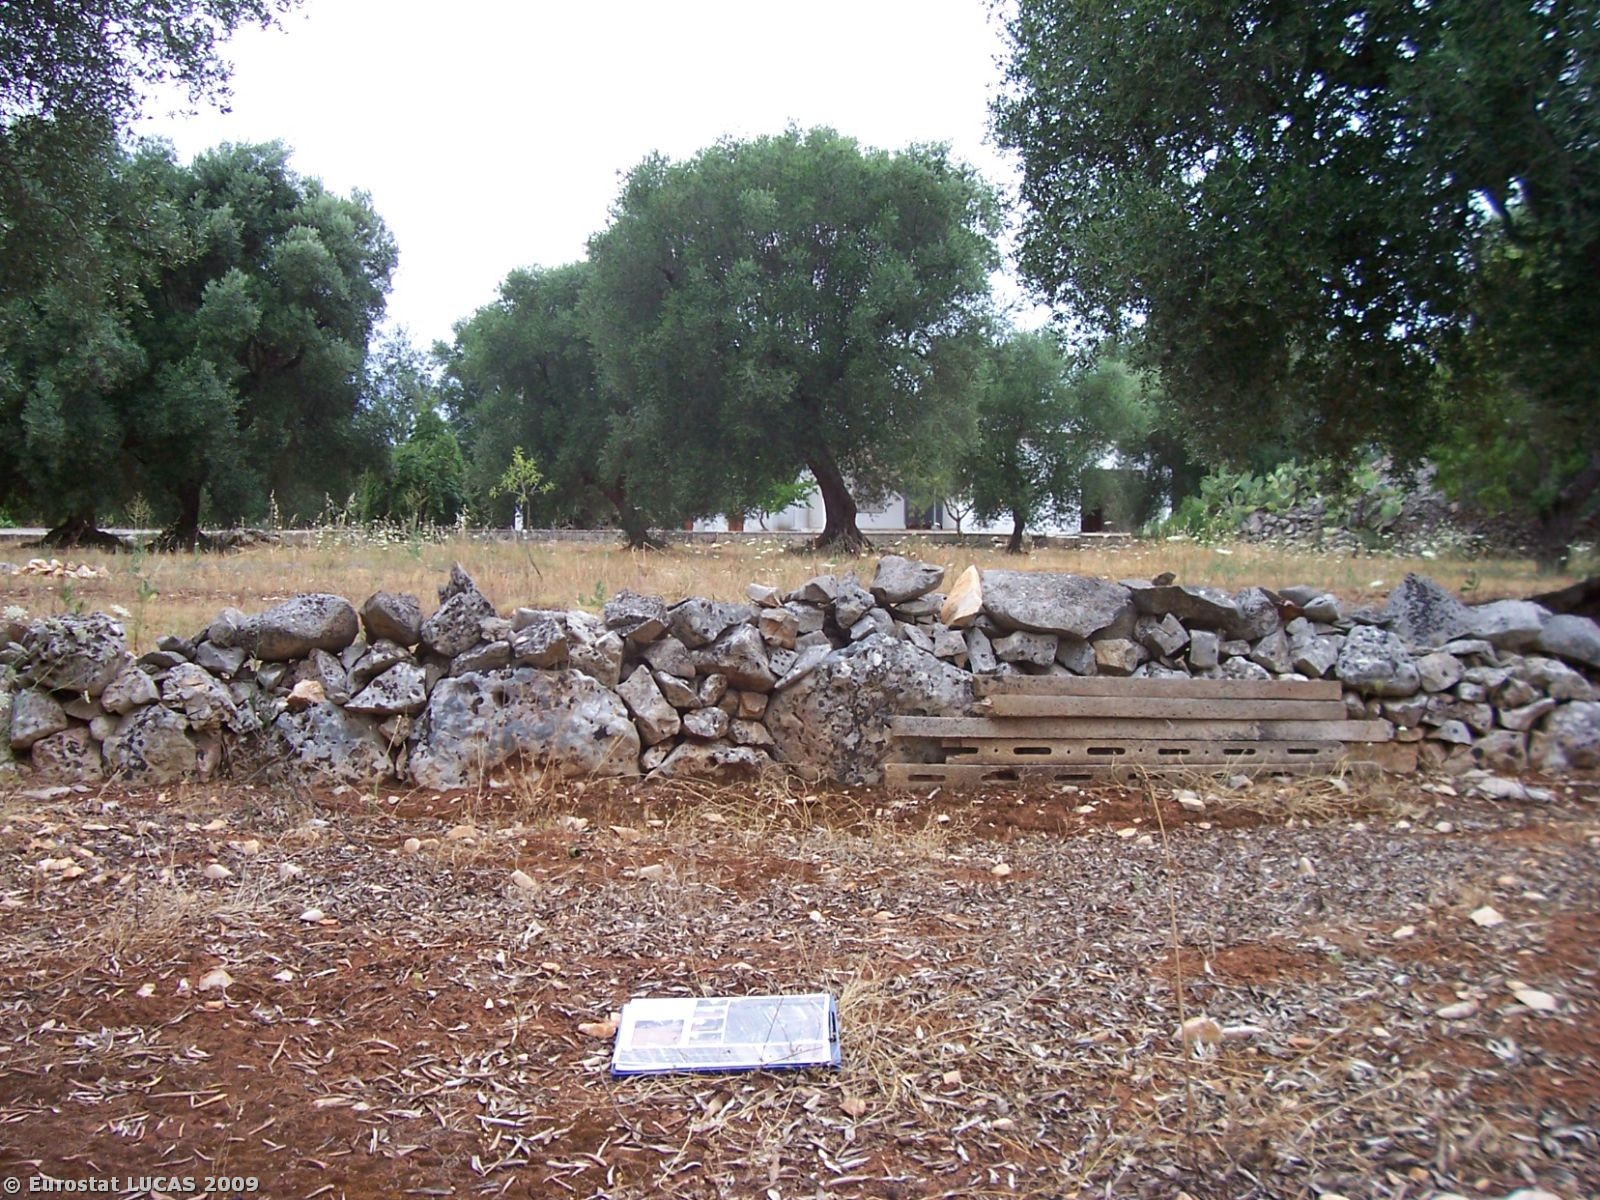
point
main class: Cropland
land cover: Olive groves
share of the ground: 25 - 50 %
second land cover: Bare land
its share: > 75 %
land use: Agriculture (excluding fallow land and kitchen gardens)
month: June
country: IT
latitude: 40.3957
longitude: 17.5271
